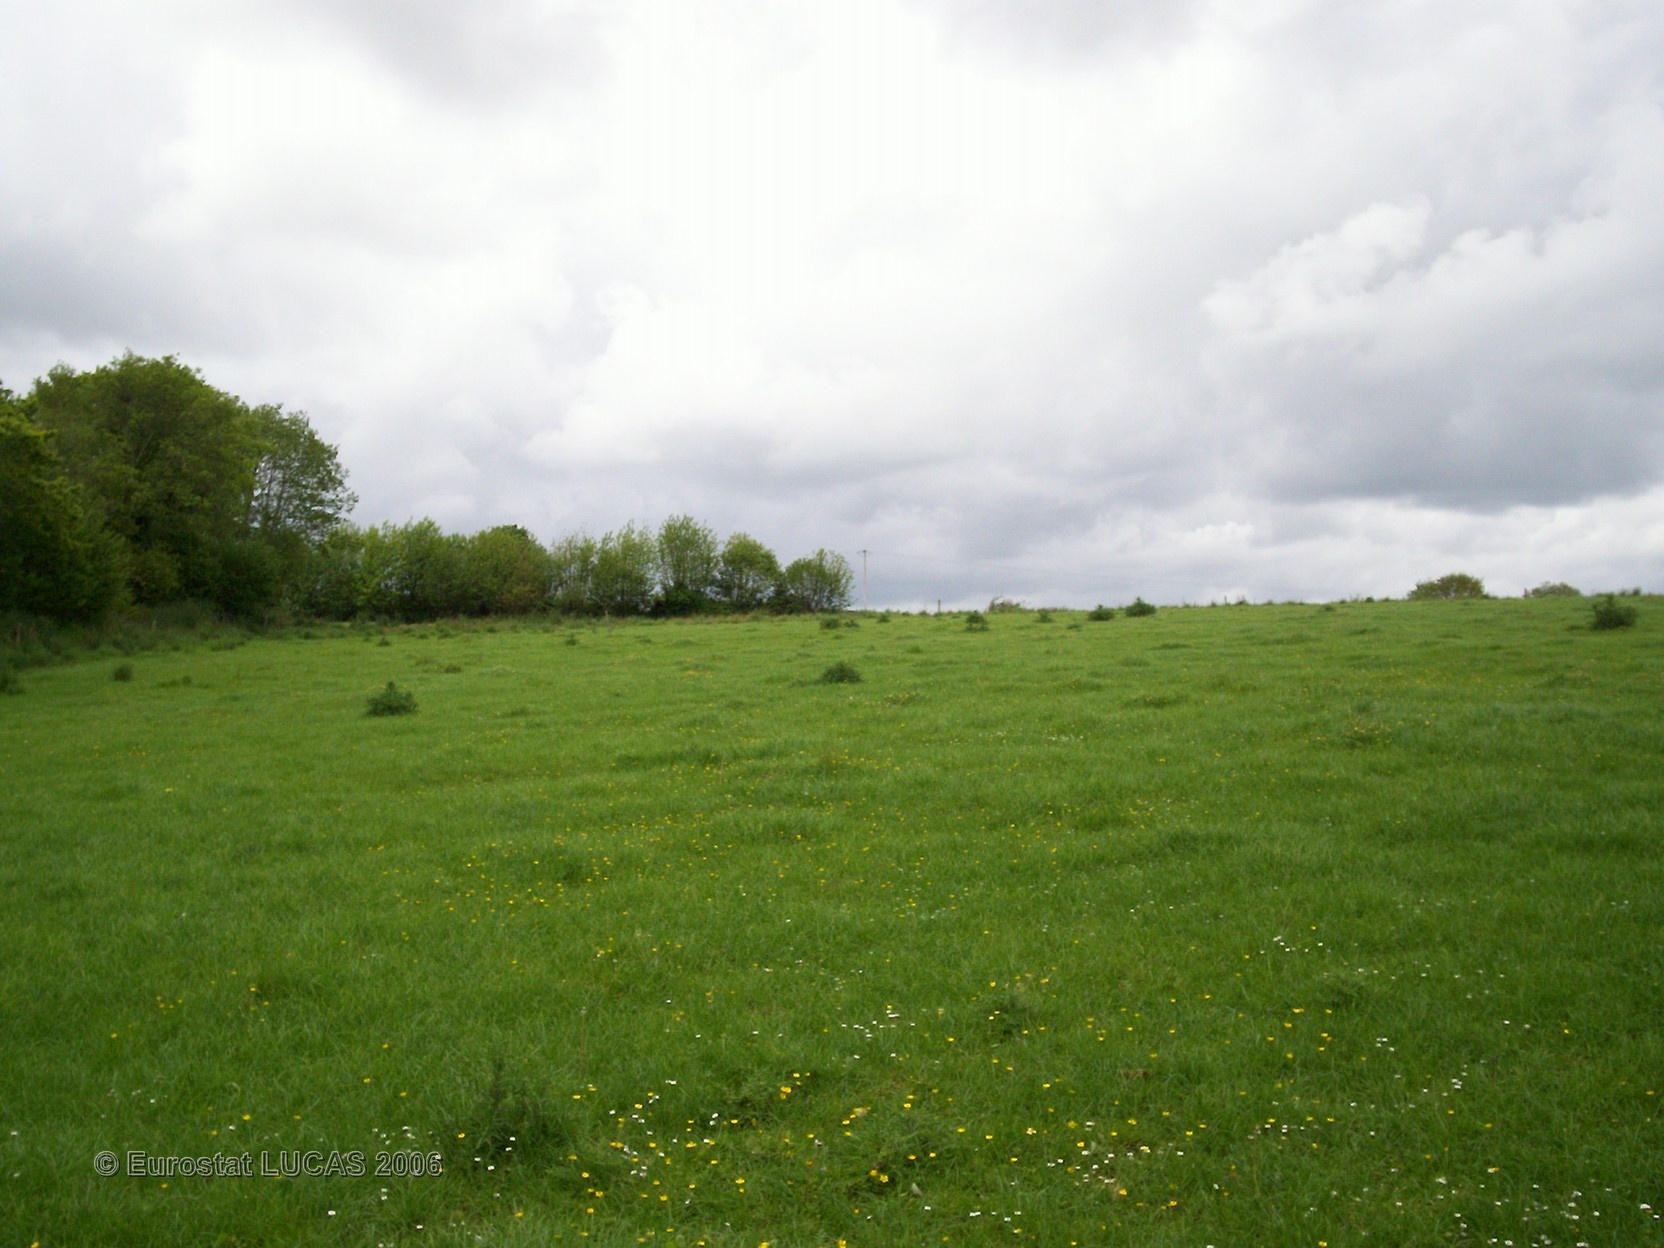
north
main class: Grassland
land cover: Grassland without tree/shrub cover
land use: Agriculture (excluding fallow land and kitchen gardens)
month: May
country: FR
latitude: 48.1039
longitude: -3.9038
